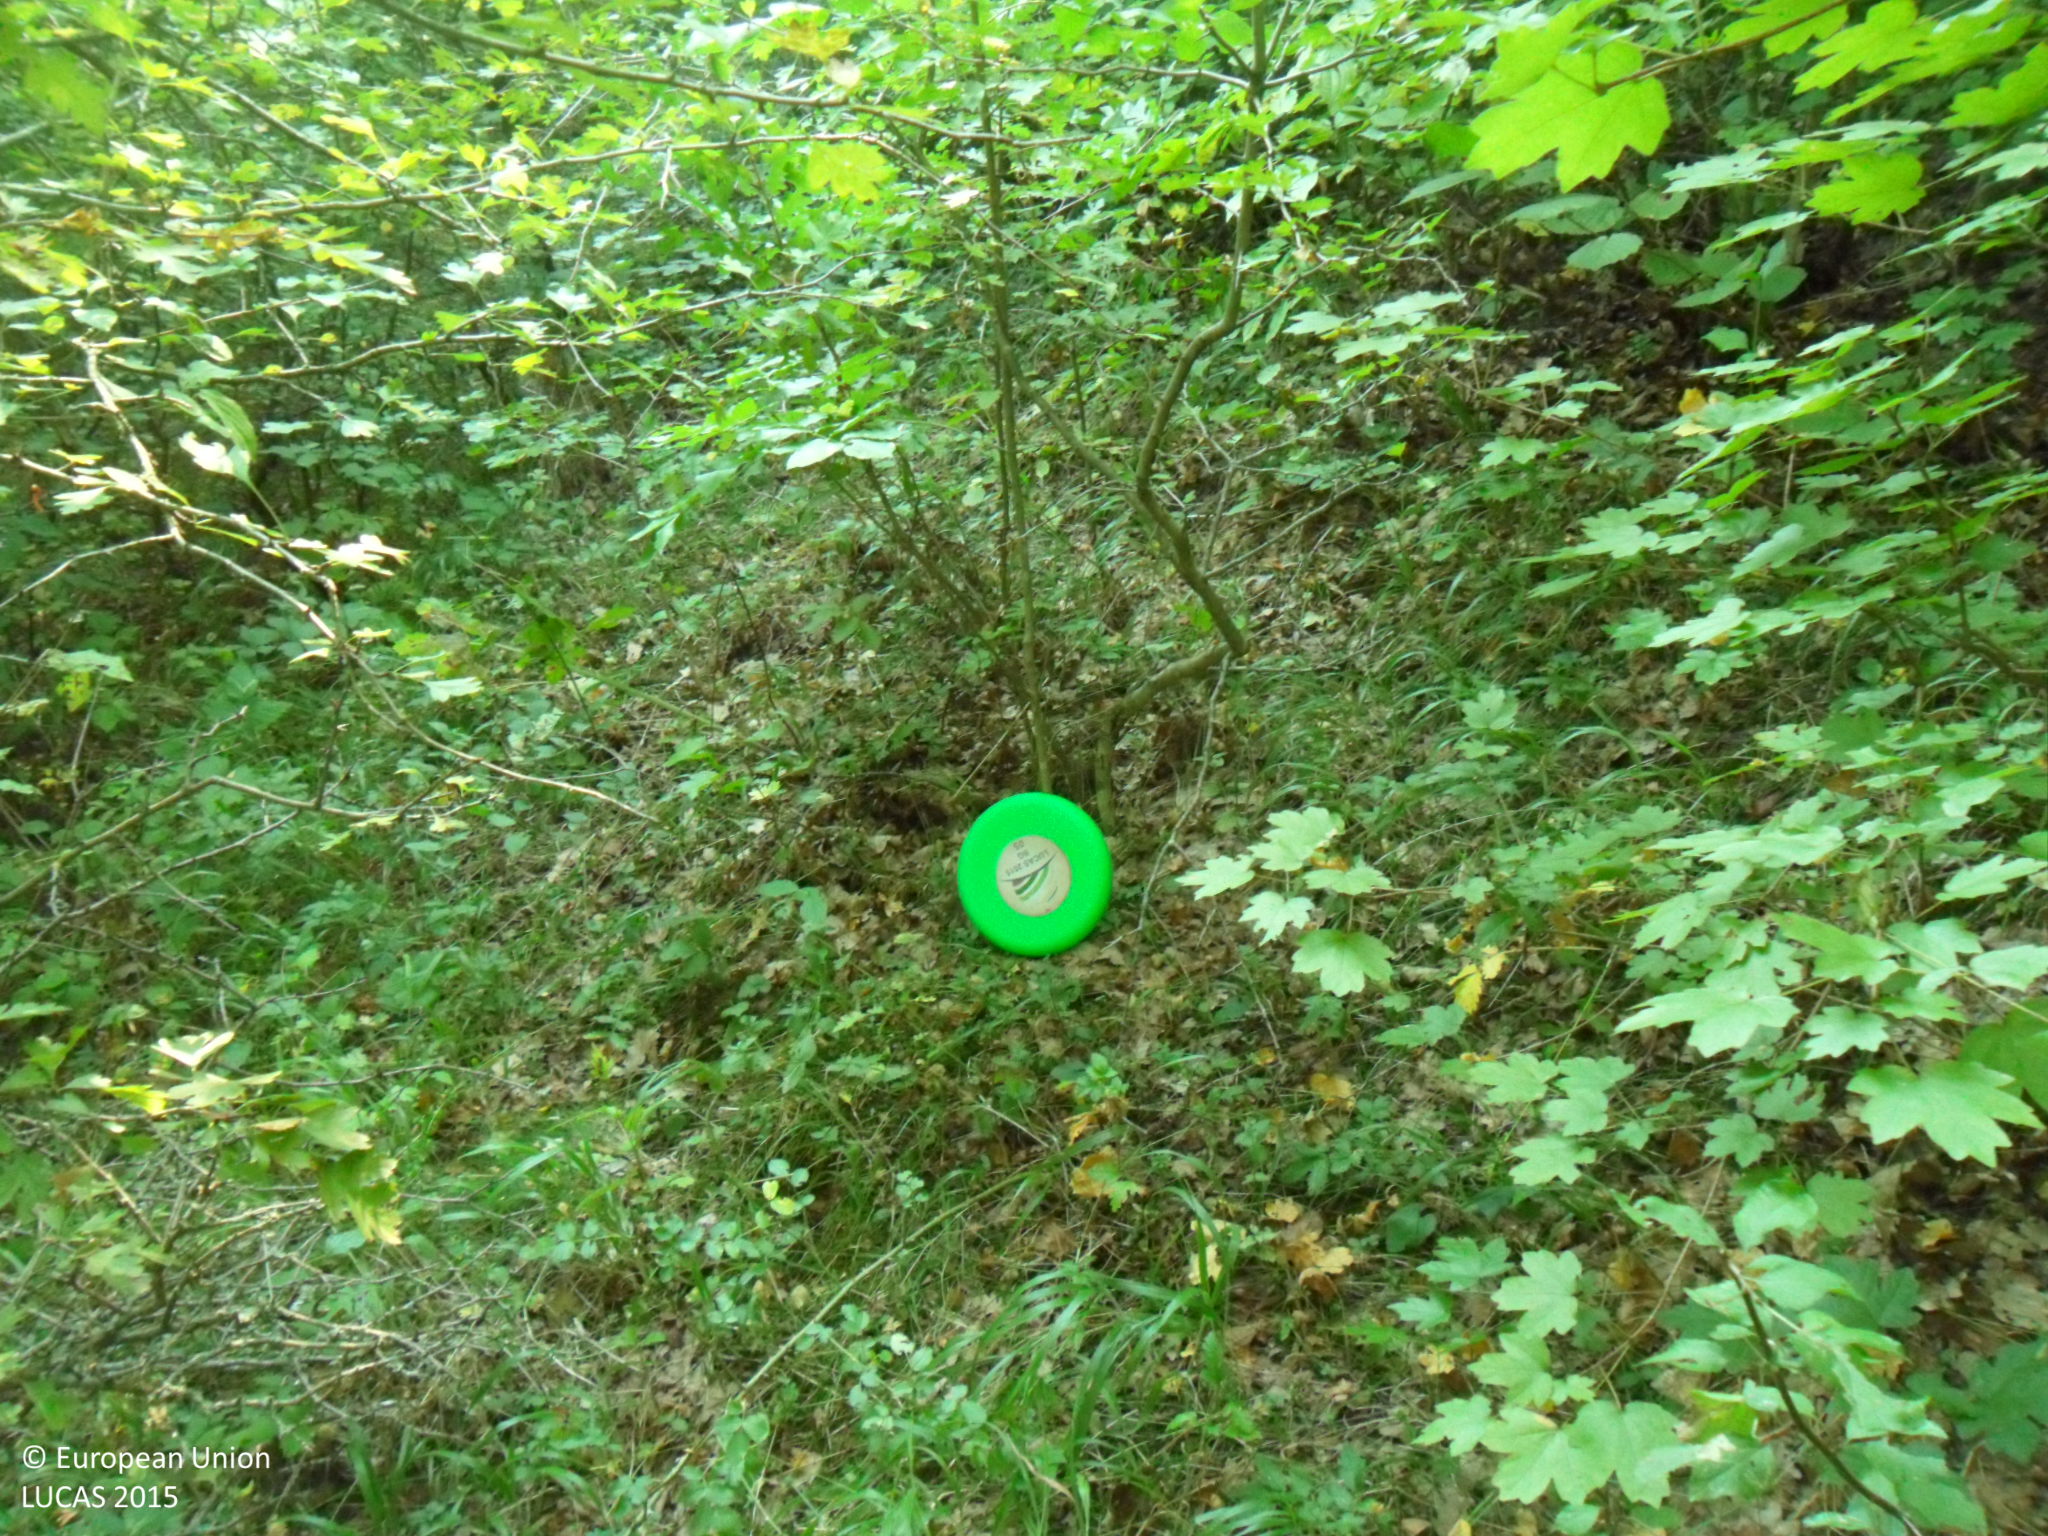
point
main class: Woodland
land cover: Broadleaved woodland
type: mesophytic deciduous forest
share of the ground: 25 - 50 %
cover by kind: shrubs 60 %, broadleaved forest trees 30 %, herbaceous plants 10 %
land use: Forestry
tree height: > 5 m
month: September
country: BG
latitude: 43.4838
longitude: 26.6895
